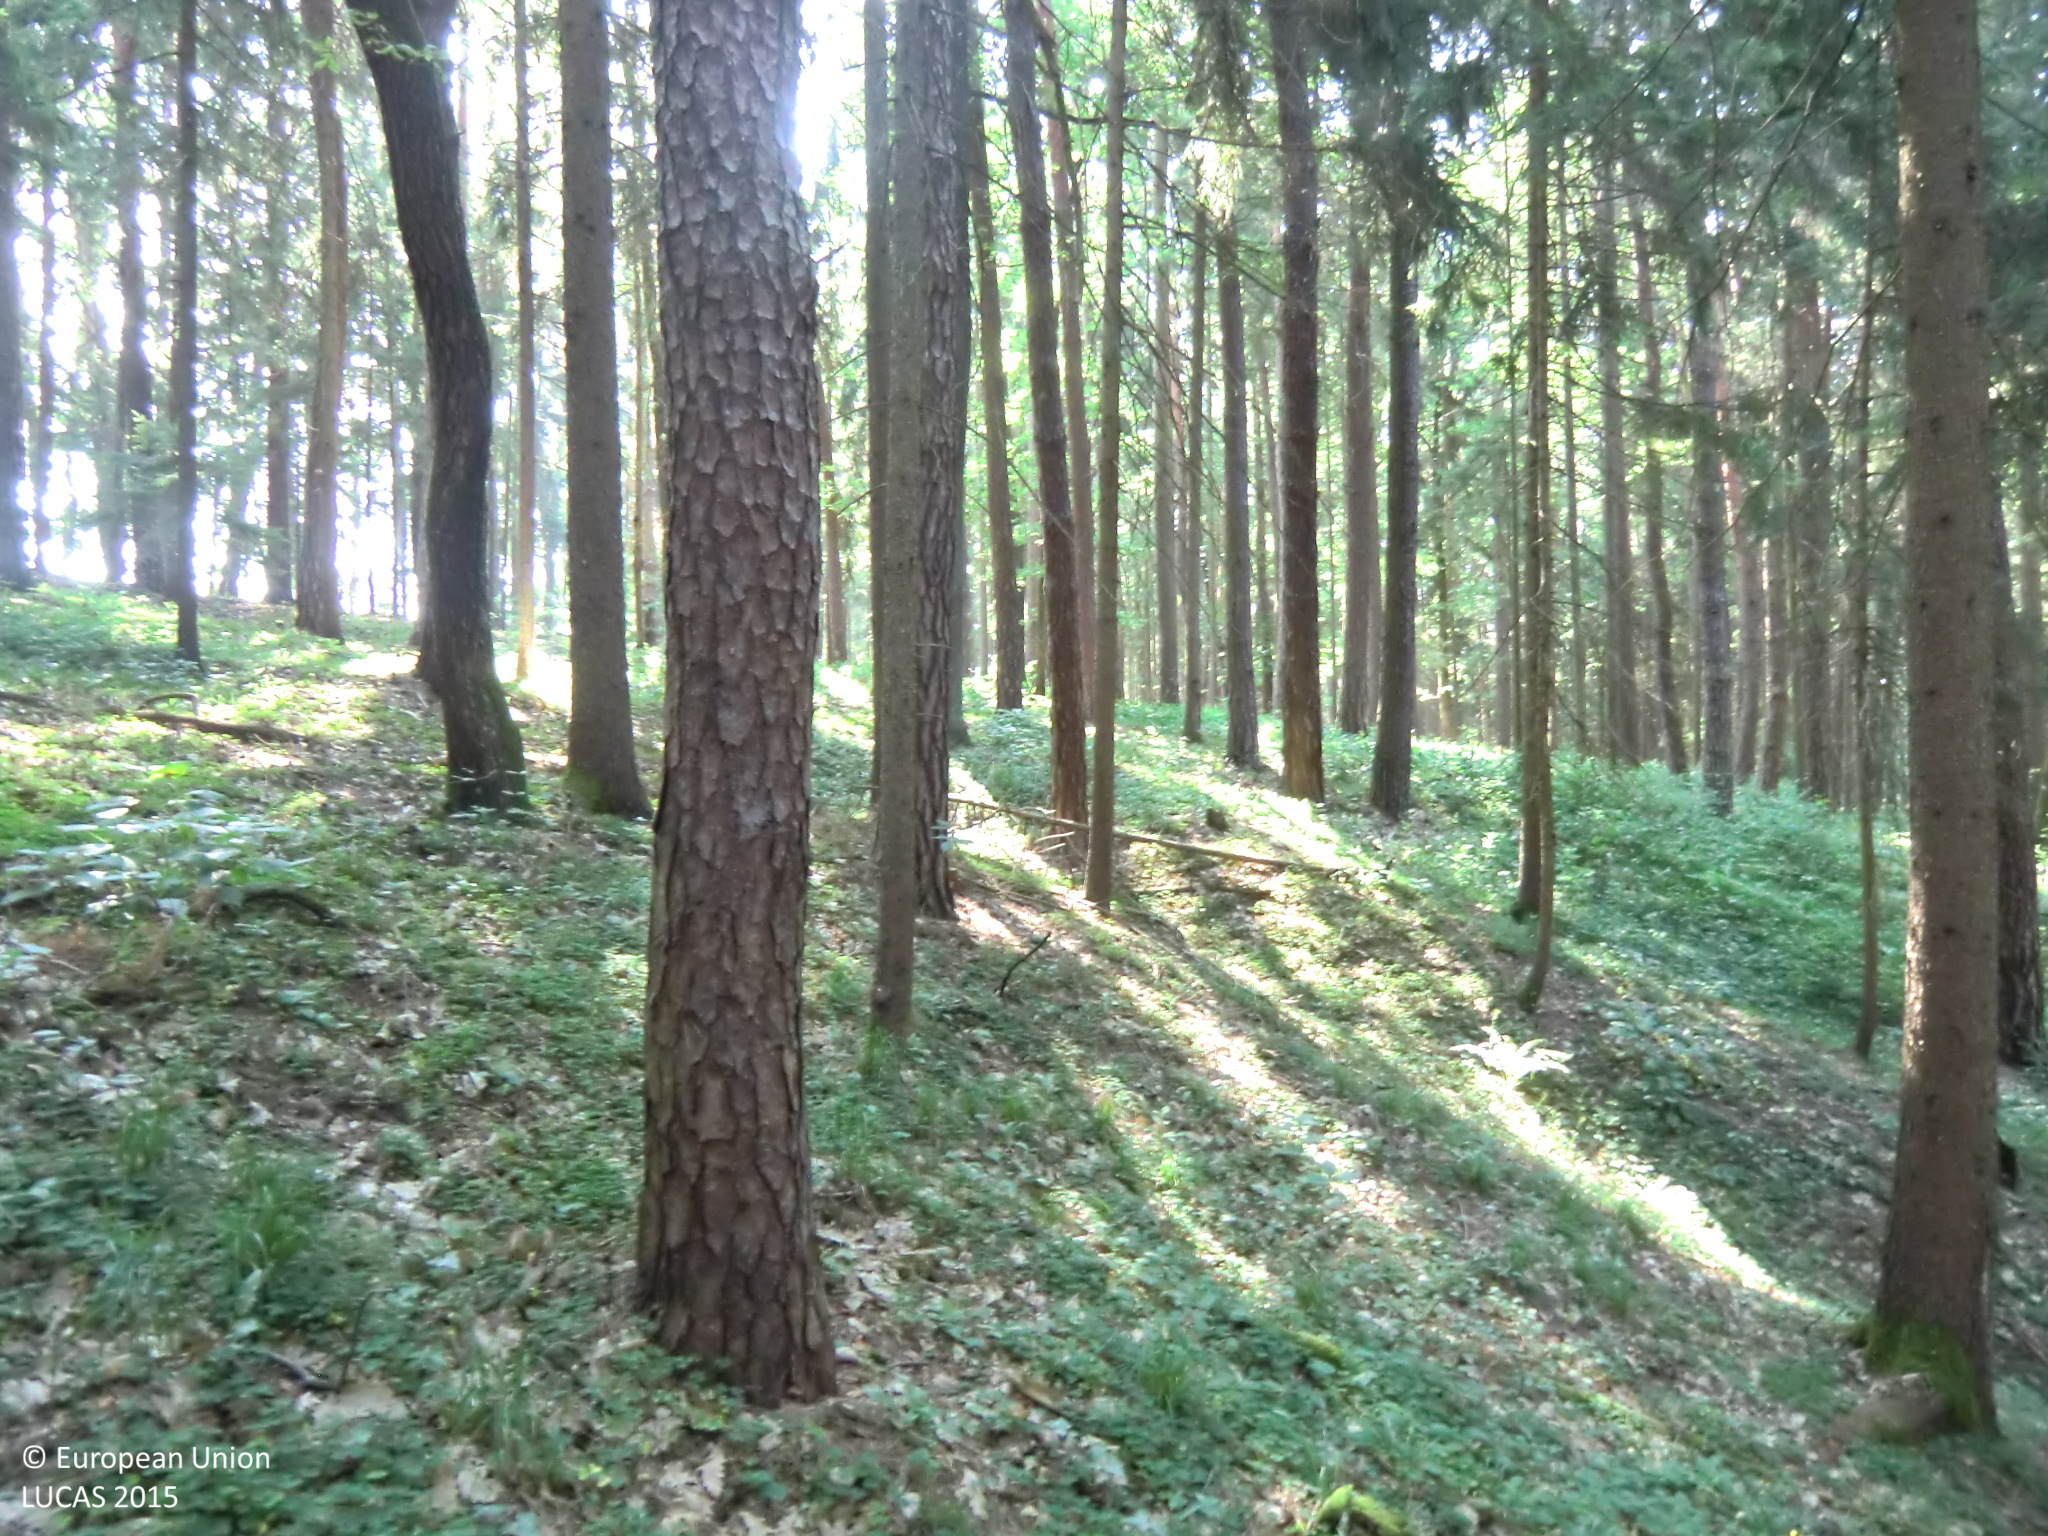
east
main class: Woodland
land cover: Other coniferous woodland
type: hemiboreal forest and nemoral coniferous forest and mixed broadleaved-coniferous forest
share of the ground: > 75 %
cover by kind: coniferous forest trees 75 %, broadleaved forest trees 10 %, herbaceous plants 10 %, unconsolidated bare surface 5 %
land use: Forestry
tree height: > 5 m
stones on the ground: < 10 %
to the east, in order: Other coniferous woodland; Tracks; Grass margins; Barley; Broadleaved woodland; Temporary grasslands; Broadleaved woodland
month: July
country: AT
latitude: 47.1502
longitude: 16.1342
